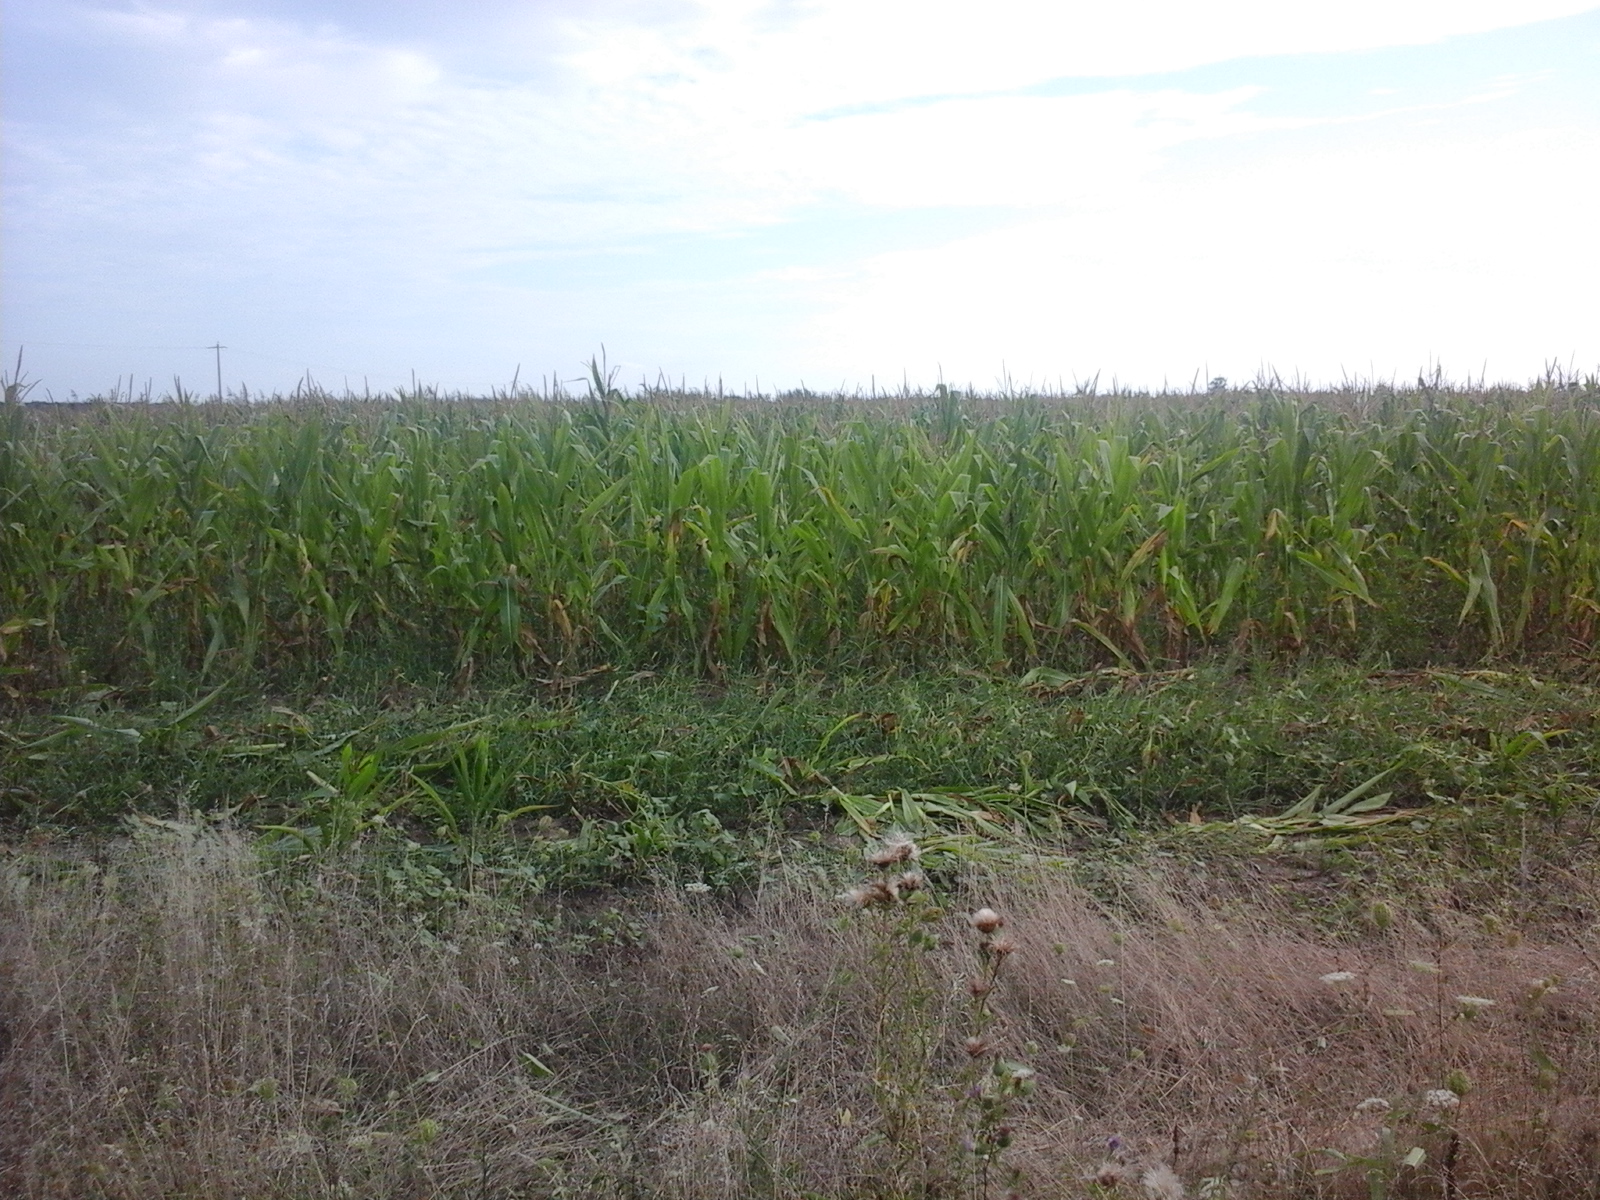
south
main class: Grassland
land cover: Spontaneously vegetated surfaces
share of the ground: > 75 %
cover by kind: herbaceous plants 100 %
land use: Fallow land
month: August
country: RO
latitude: 46.7160
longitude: 21.6181
